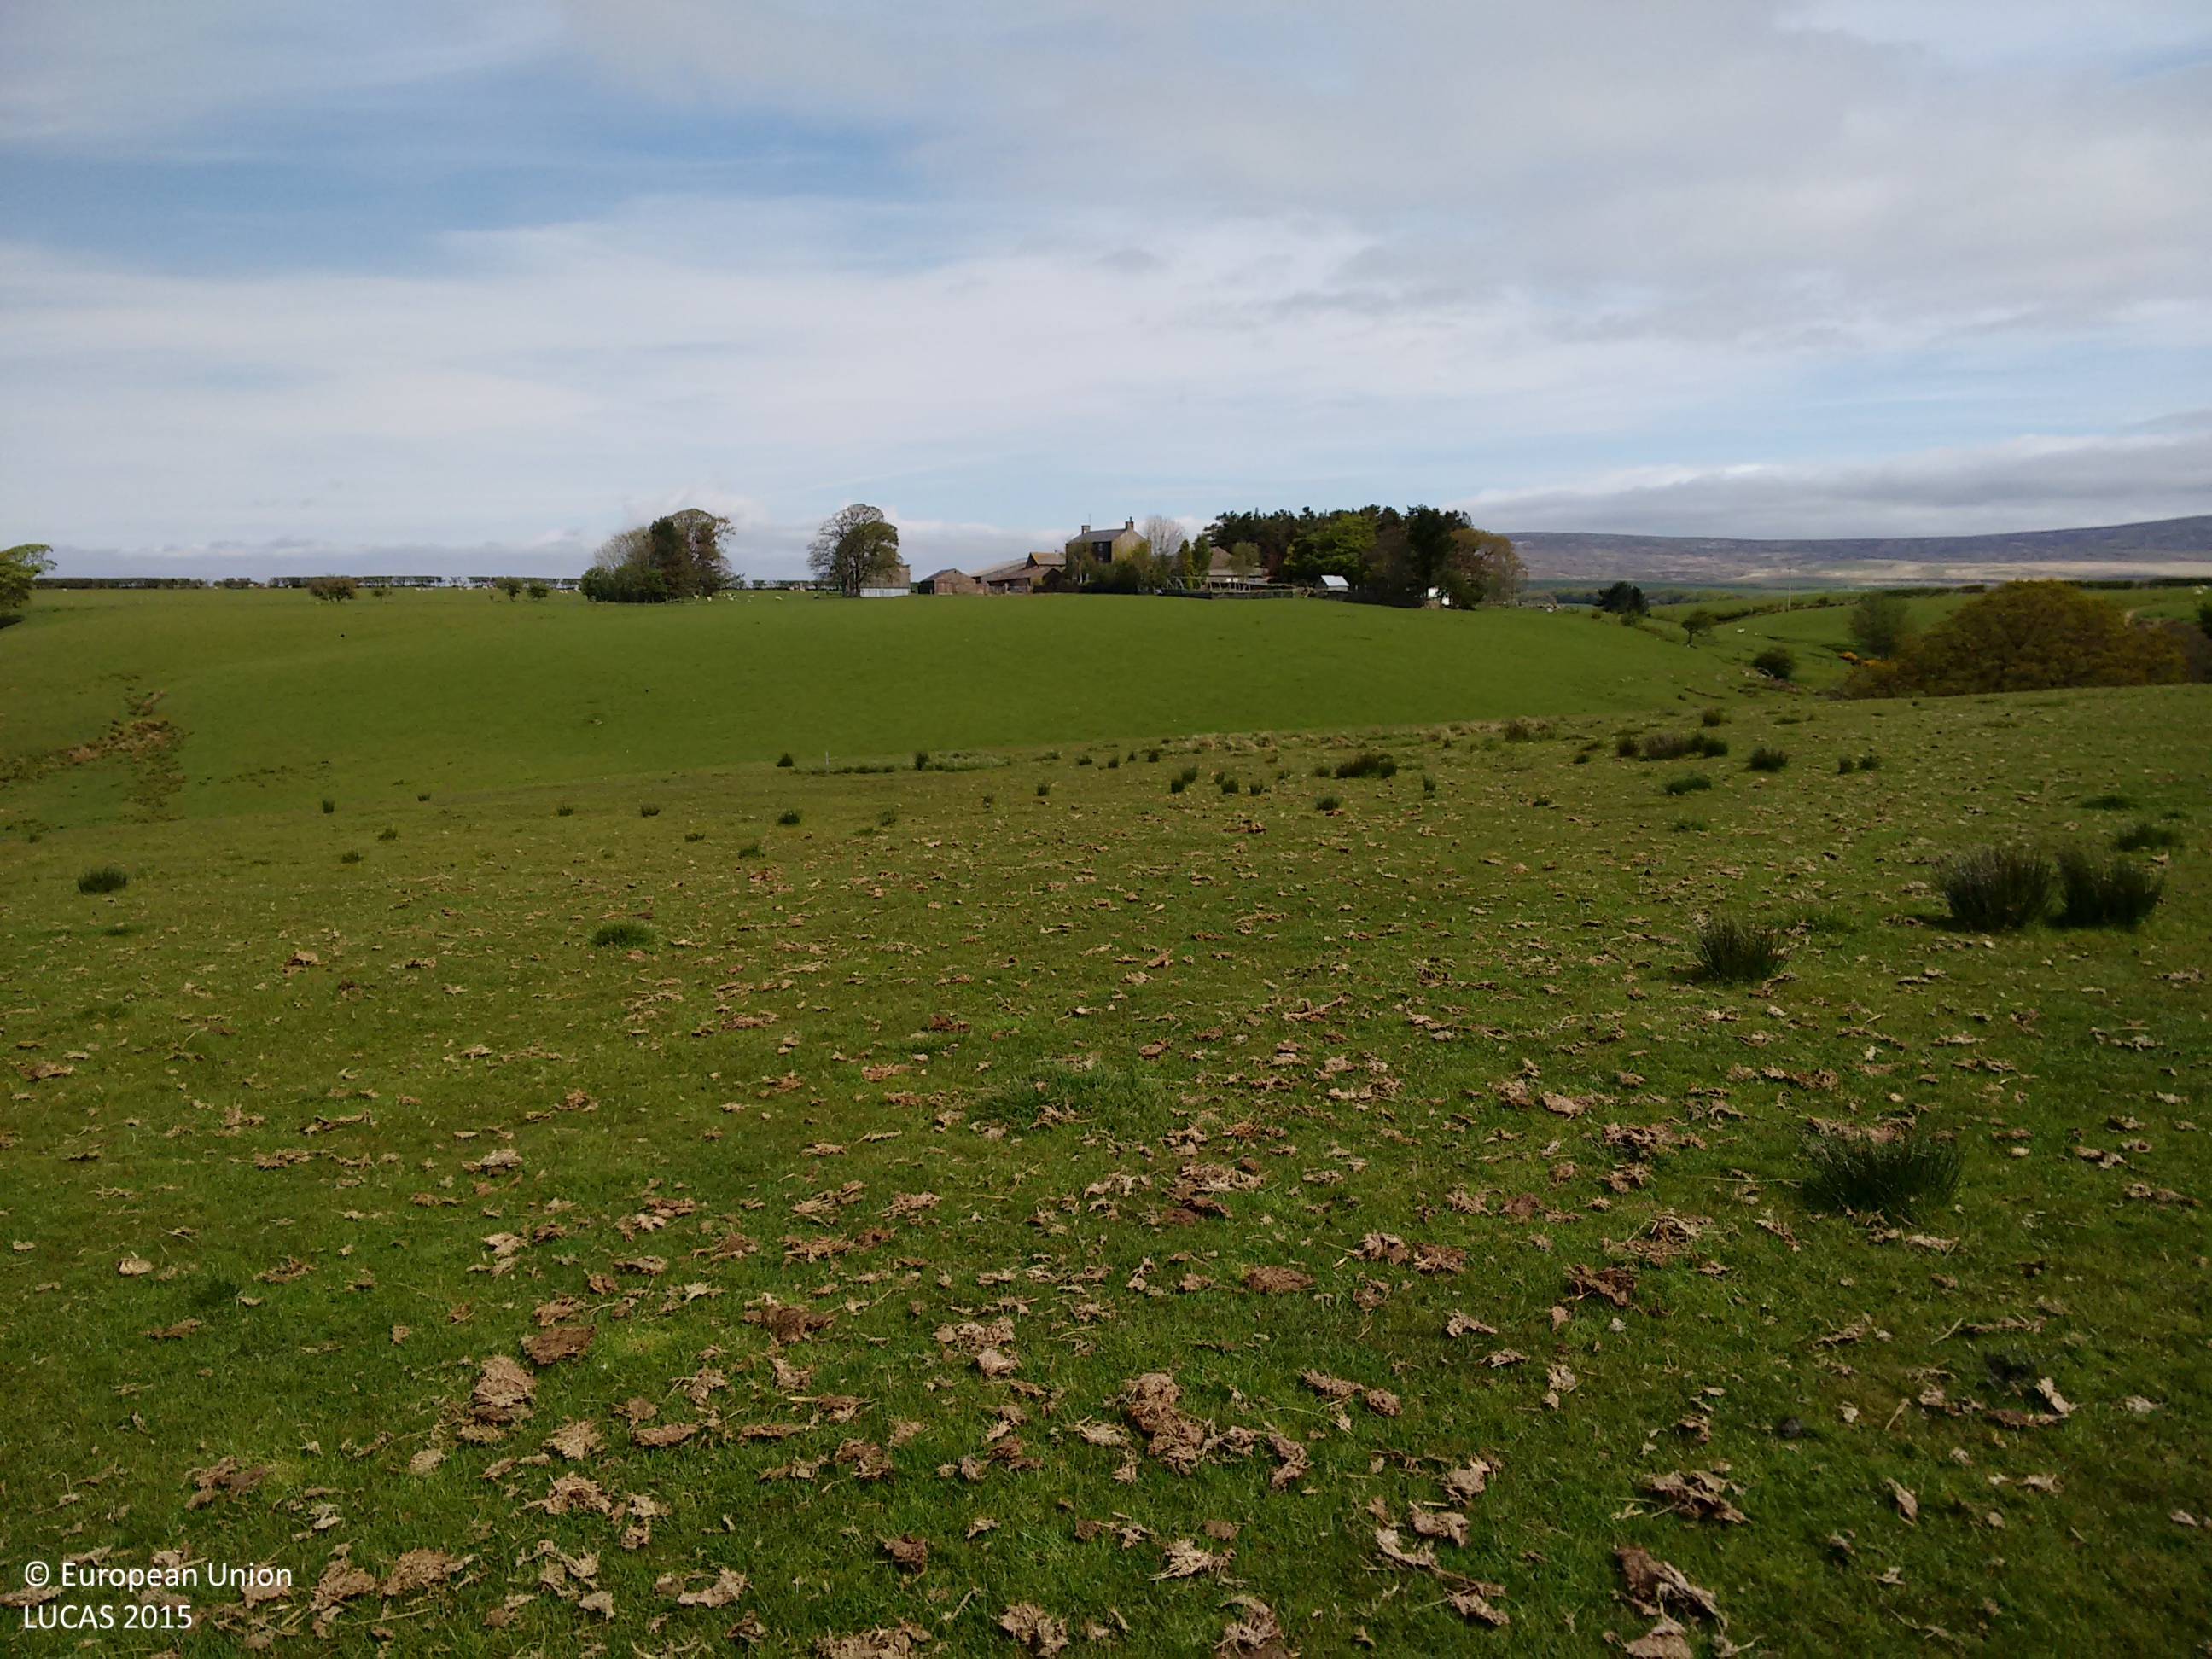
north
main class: Grassland
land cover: Grassland without tree/shrub cover
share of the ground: > 75 %
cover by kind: herbaceous plants 100 %
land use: Agriculture (excluding fallow land and kitchen gardens)
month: May
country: GB
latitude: 53.9677
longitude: -2.7054
